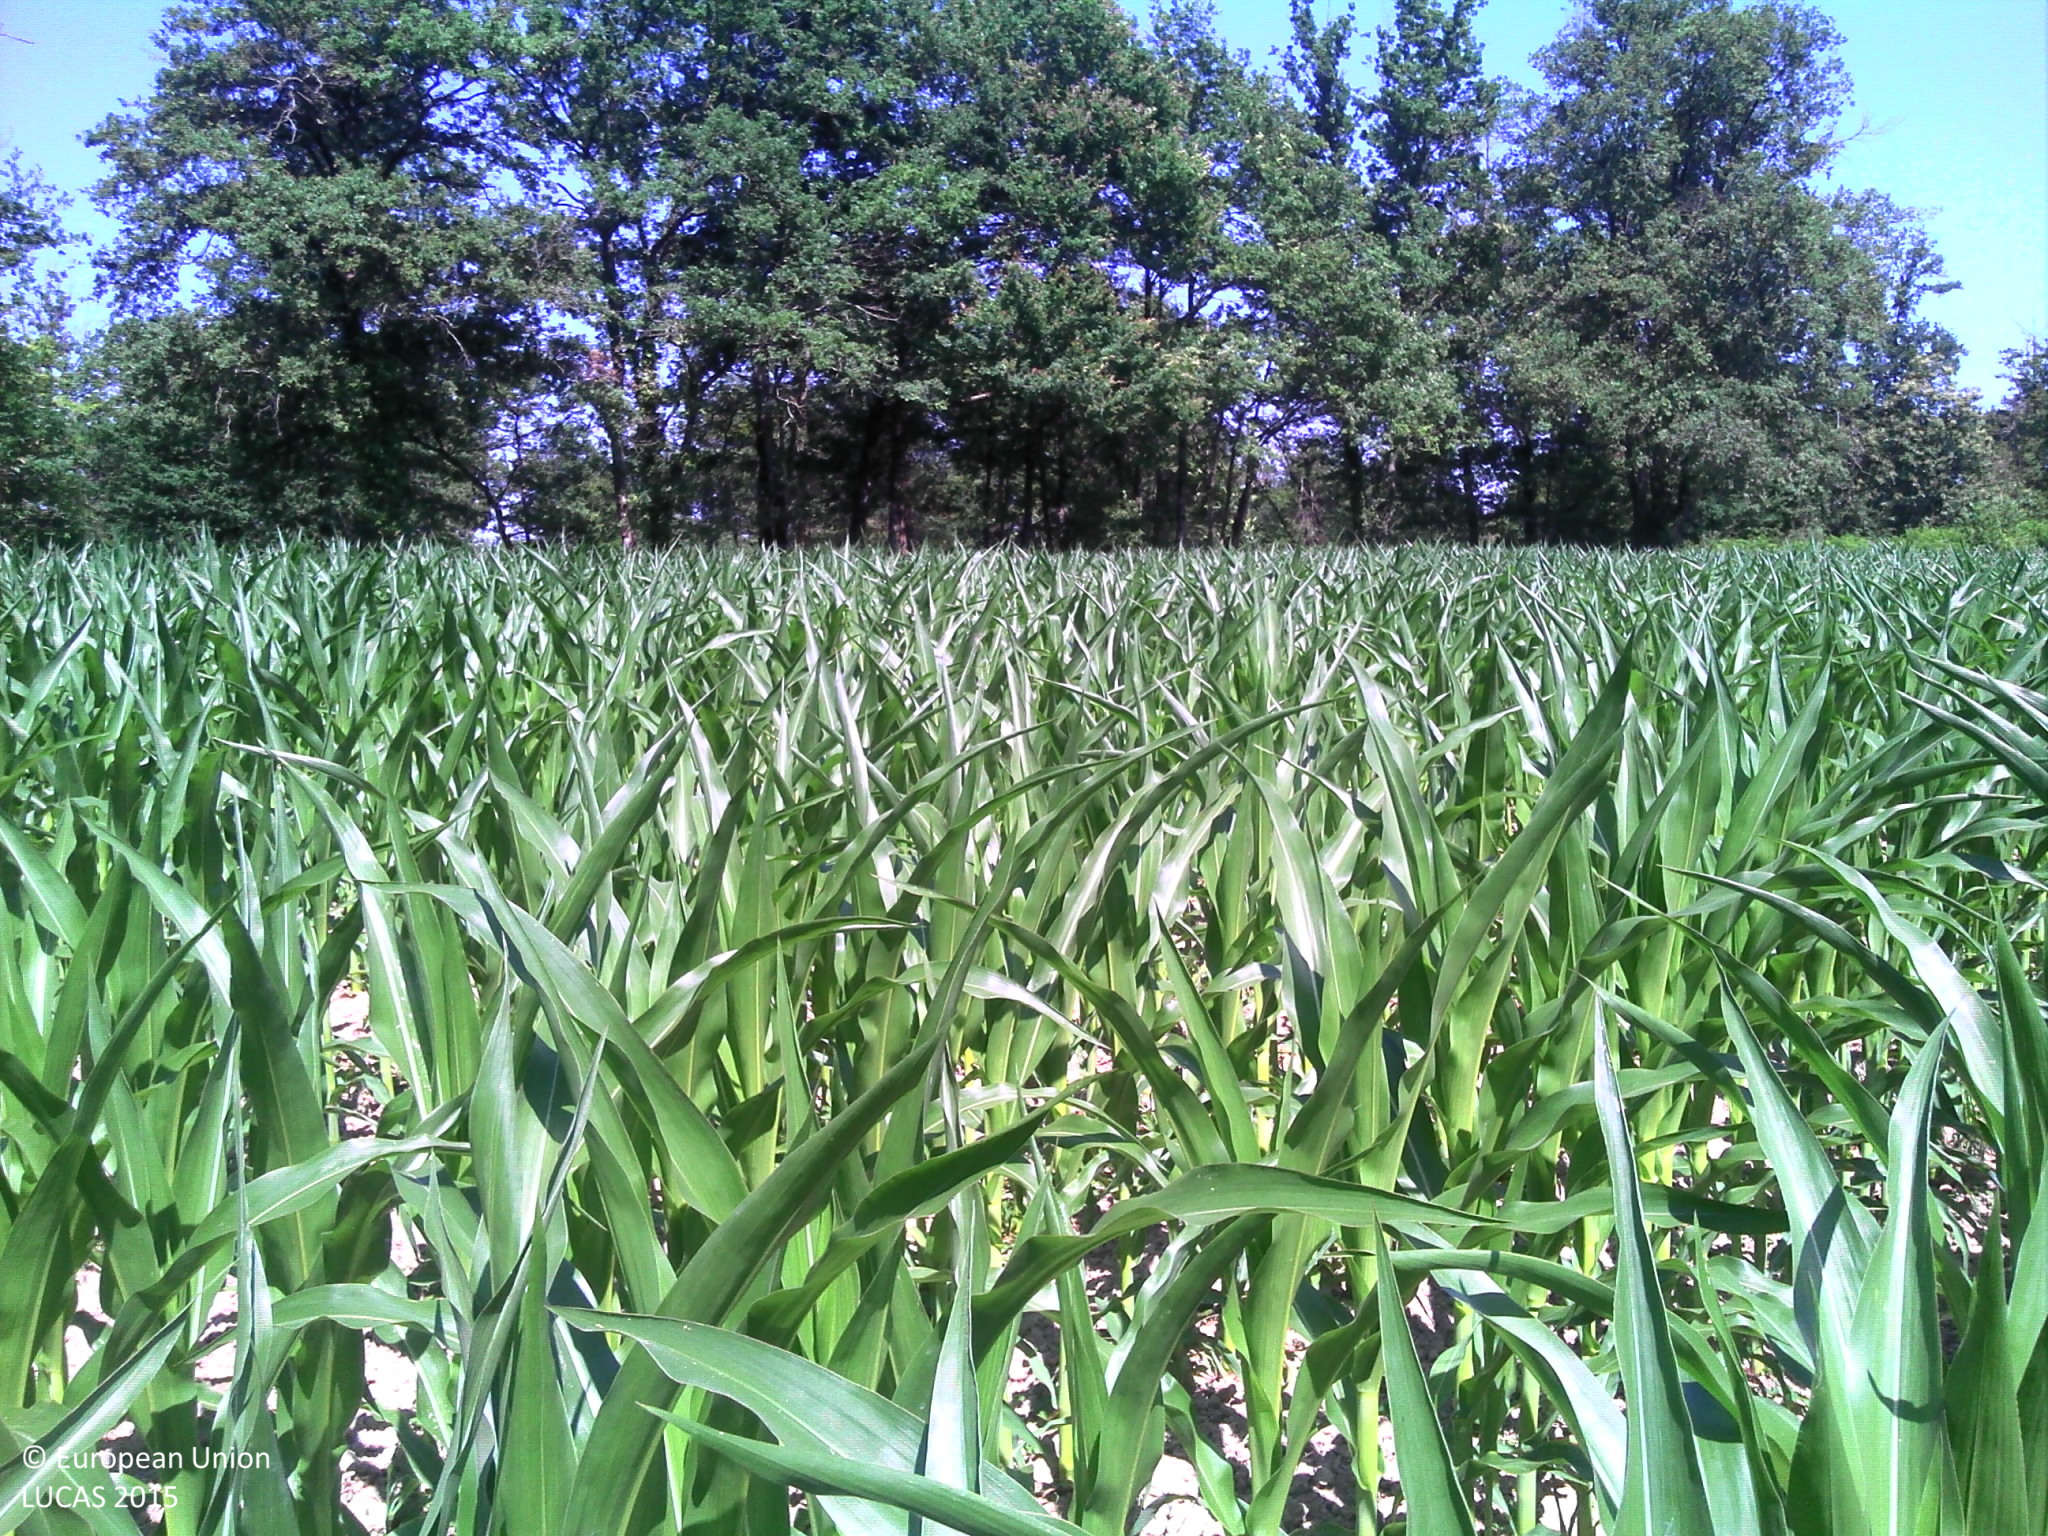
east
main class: Cropland
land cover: Maize
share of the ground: > 75 %
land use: Agriculture (excluding fallow land and kitchen gardens)
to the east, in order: Maize; Broadleaved woodland; Shrubland with sparse tree cover; Broadleaved woodland; Shrubland with sparse tree cover; Fences
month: June
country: FR
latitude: 43.7940
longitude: -0.3626
